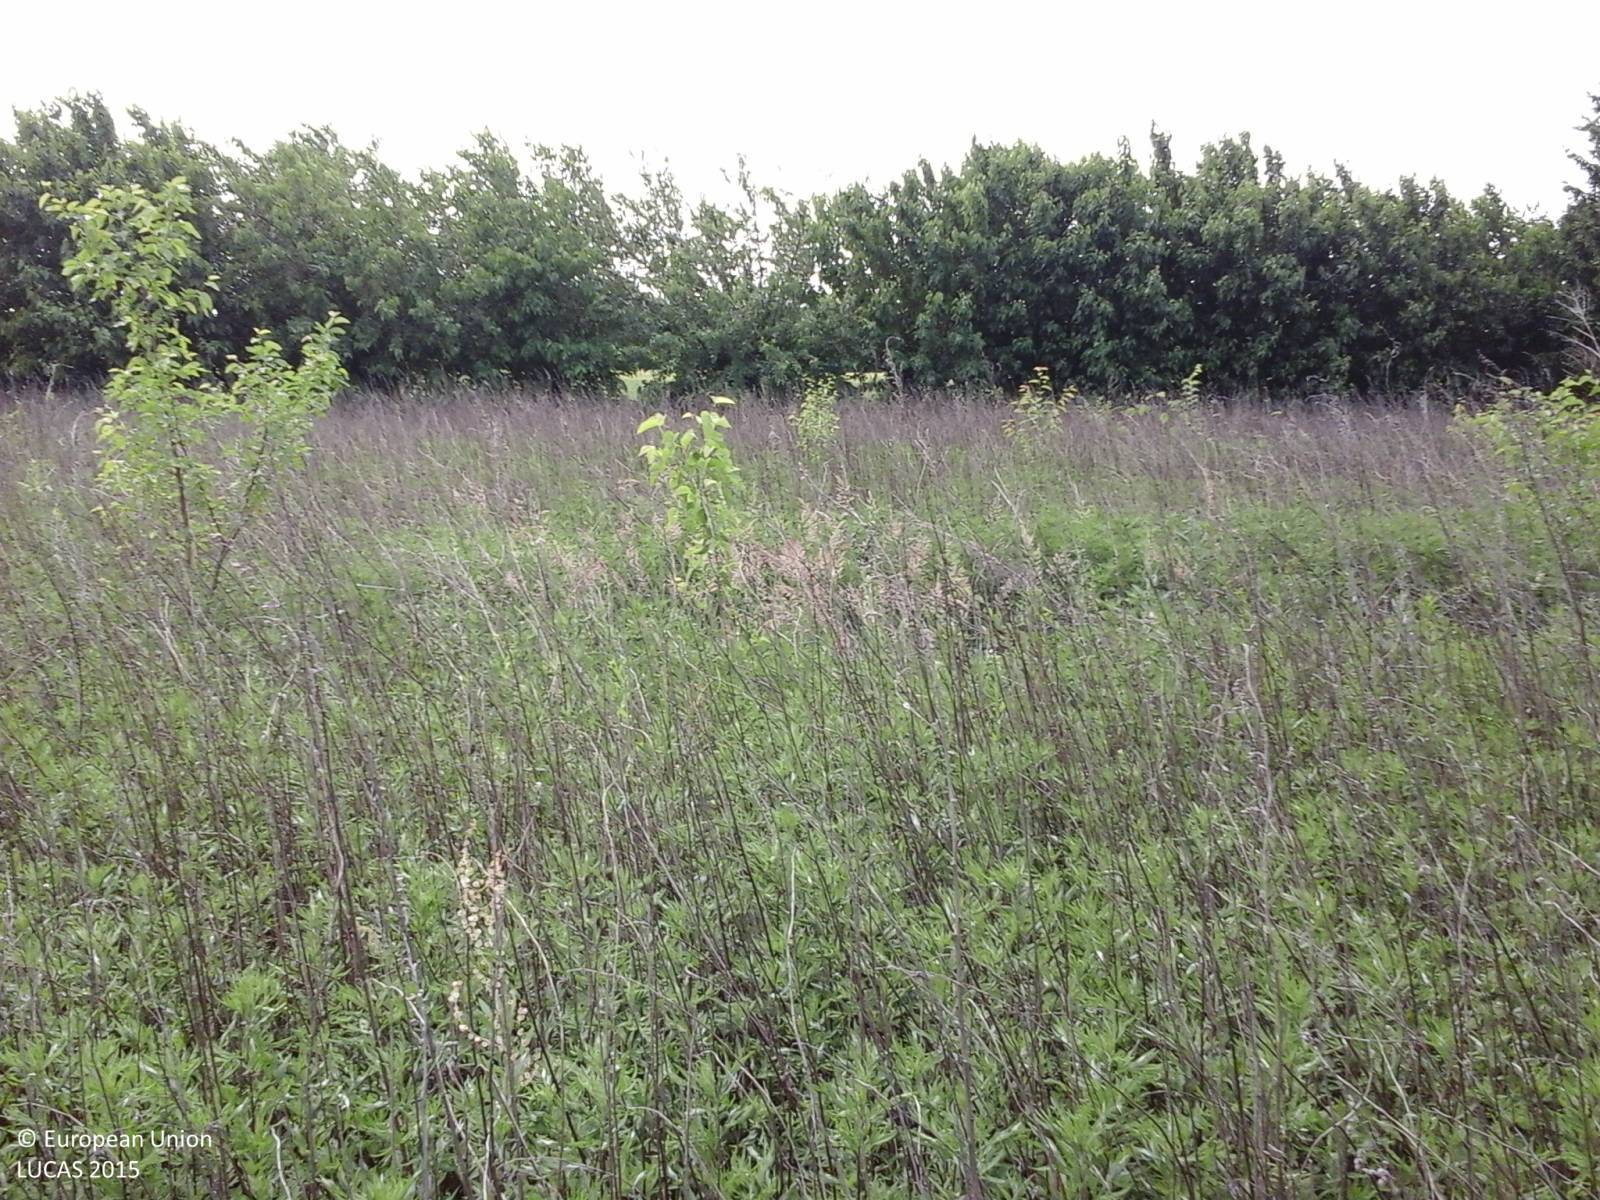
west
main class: Grassland
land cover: Spontaneously vegetated surfaces
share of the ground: > 75 %
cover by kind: herbaceous plants 100 %
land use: Fallow land
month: May
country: IT
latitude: 46.0302
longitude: 13.2908
